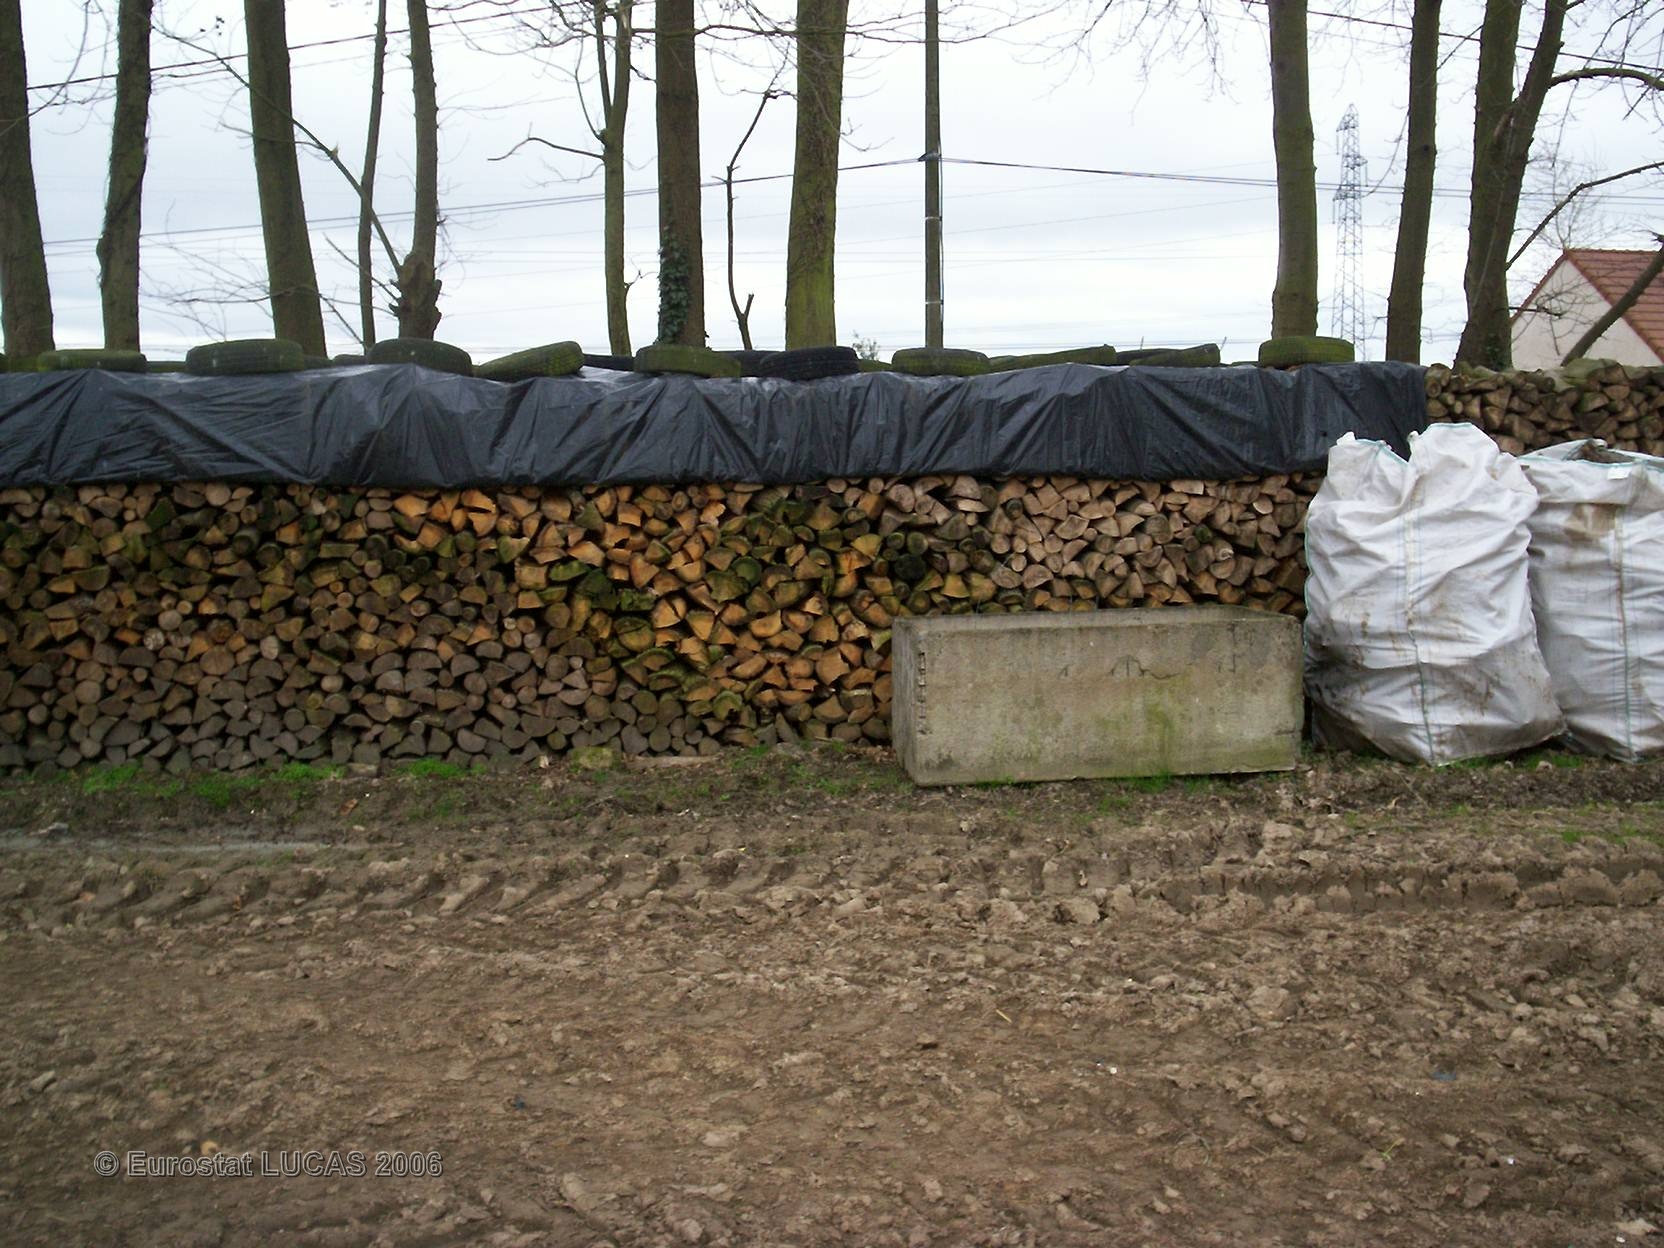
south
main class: Grassland
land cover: Grassland without tree/shrub cover
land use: Agriculture (excluding fallow land and kitchen gardens)
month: April
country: FR
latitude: 49.4988
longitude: 0.9610
